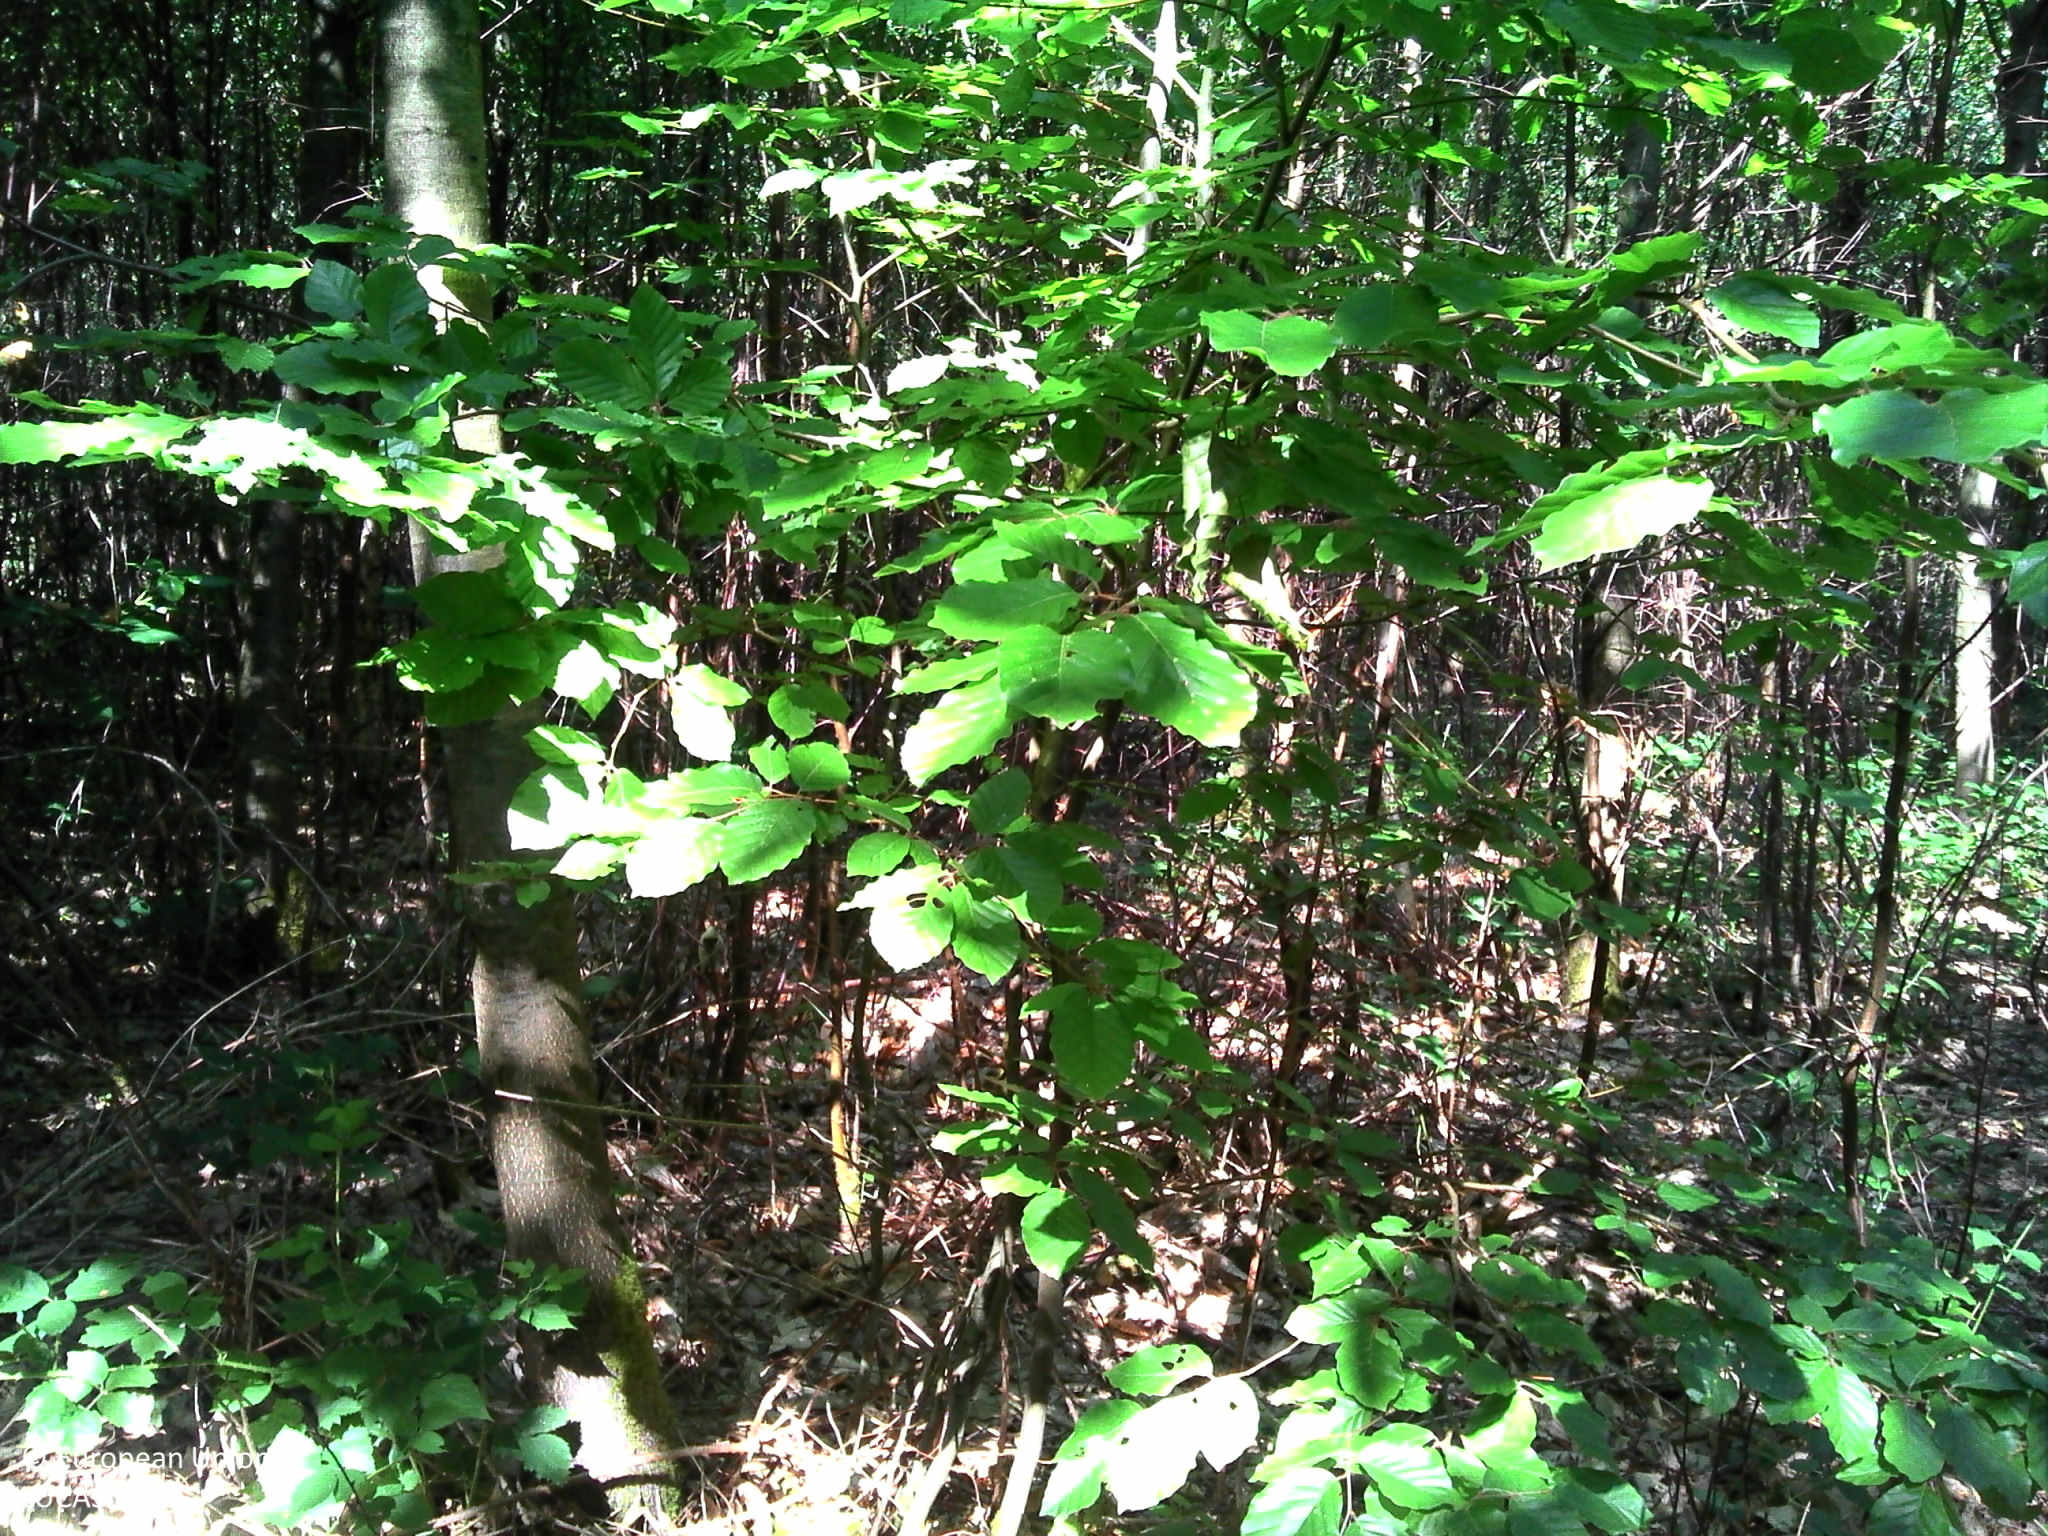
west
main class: Woodland
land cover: Broadleaved woodland
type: exotic forest
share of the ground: > 75 %
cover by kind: broadleaved forest trees 85 %, herbaceous plants 10 %, unconsolidated bare surface 5 %
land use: Forestry
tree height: > 5 m
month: July
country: BE
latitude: 50.2876
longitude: 4.5363
